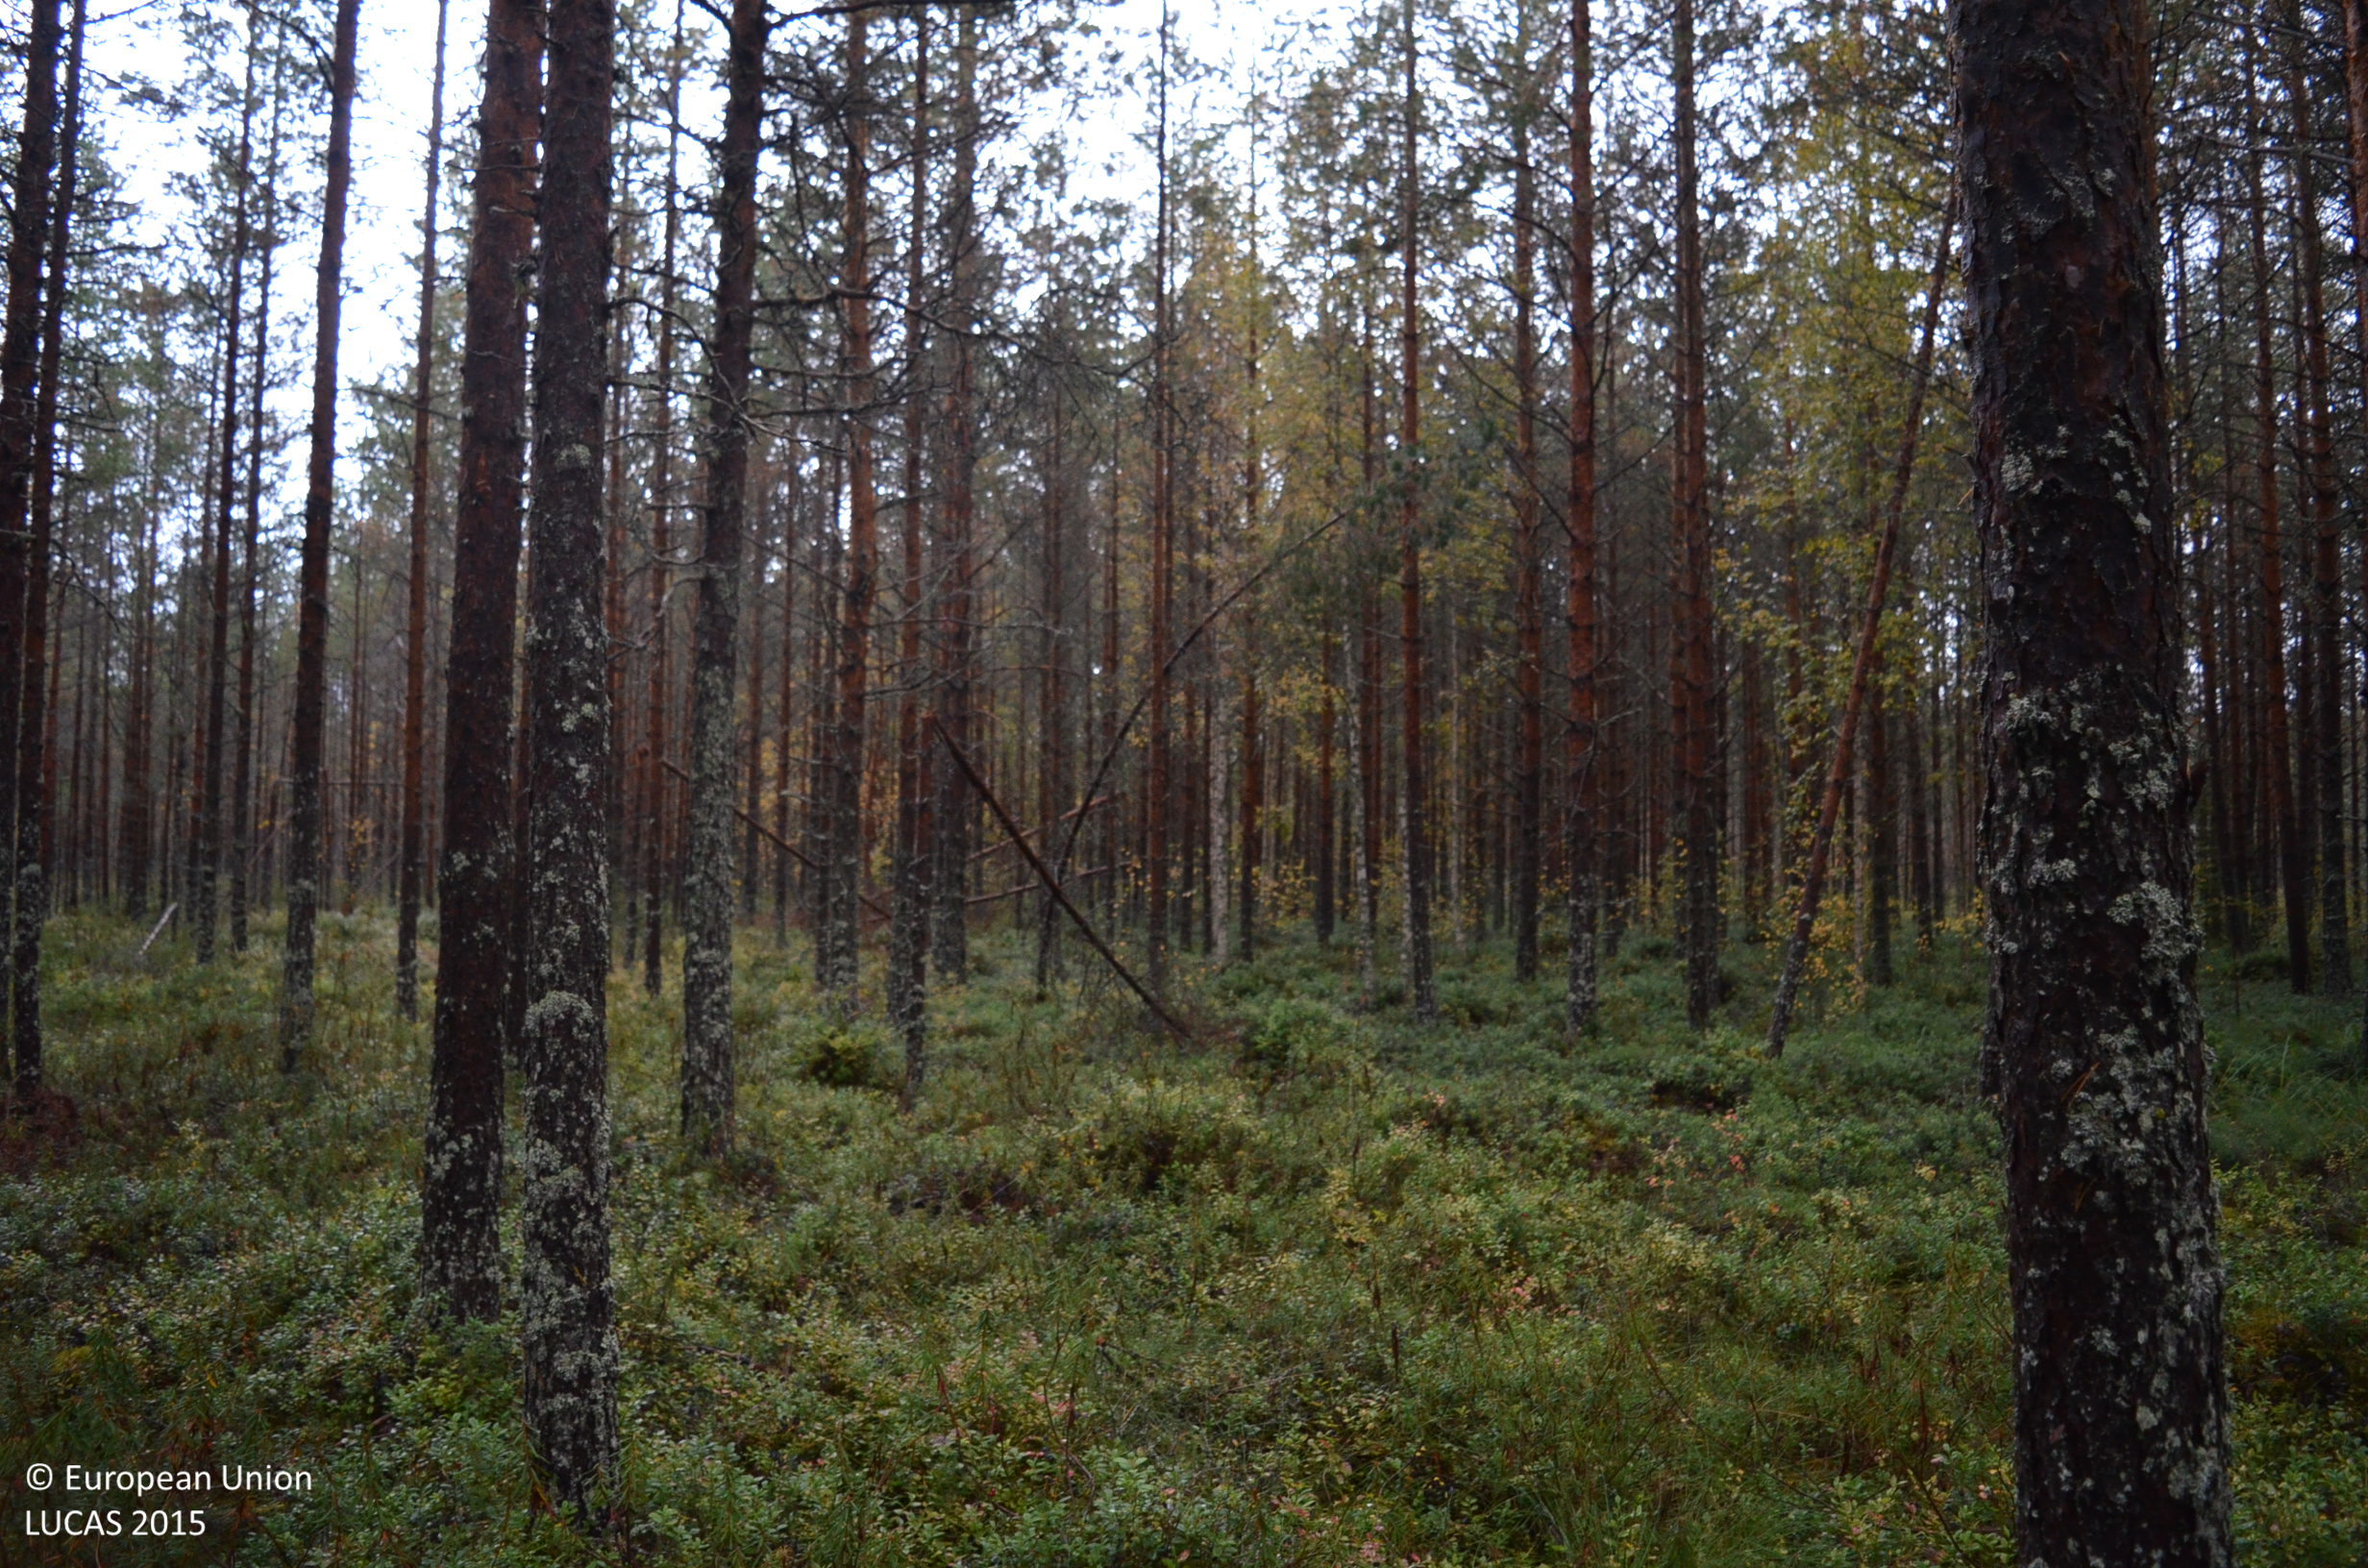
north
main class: Woodland
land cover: Pine dominated coniferous woodland
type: boreal forest
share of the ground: > 75 %
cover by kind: coniferous forest trees 65 %, shrubs 25 %, broadleaved forest trees 10 %
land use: Forestry
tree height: > 5 m
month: September
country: FI
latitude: 62.8854
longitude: 23.8602
